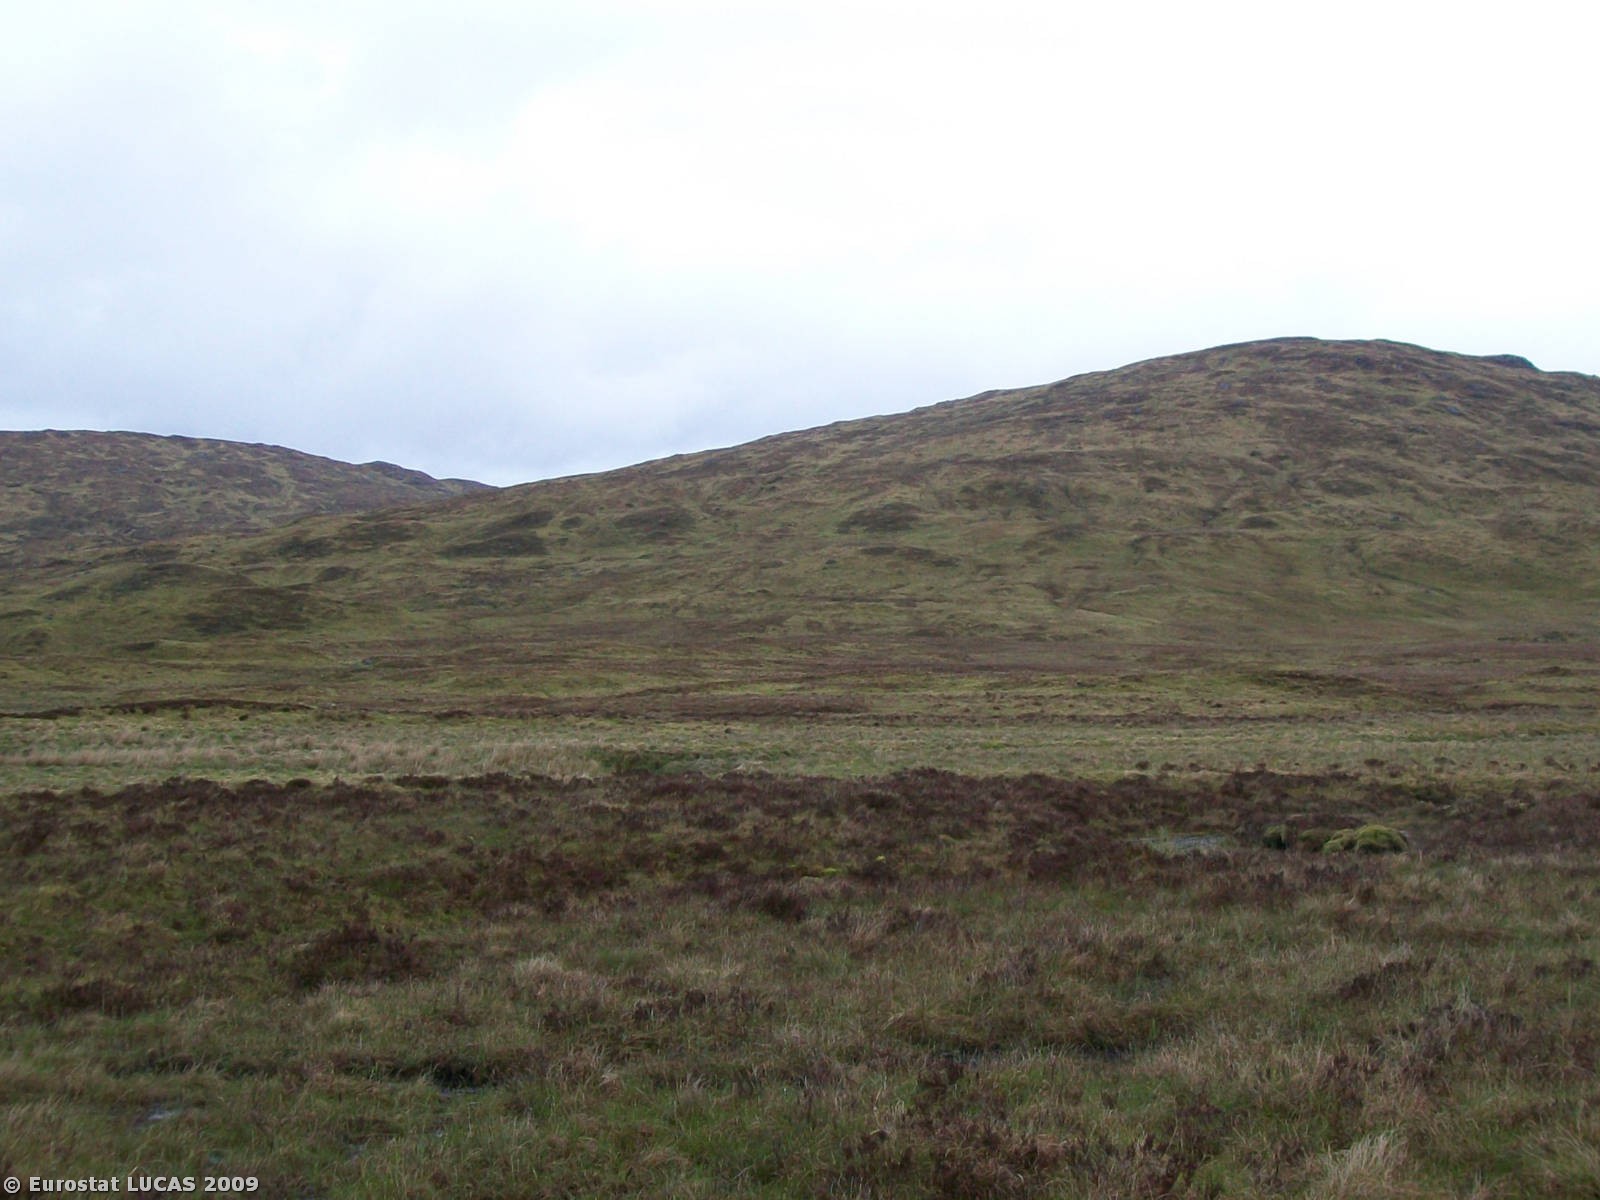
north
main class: Shrubland
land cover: Shrubland without tree cover
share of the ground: > 75 %
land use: Nature reserves
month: May
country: GB
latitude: 56.5723
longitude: -4.7667
